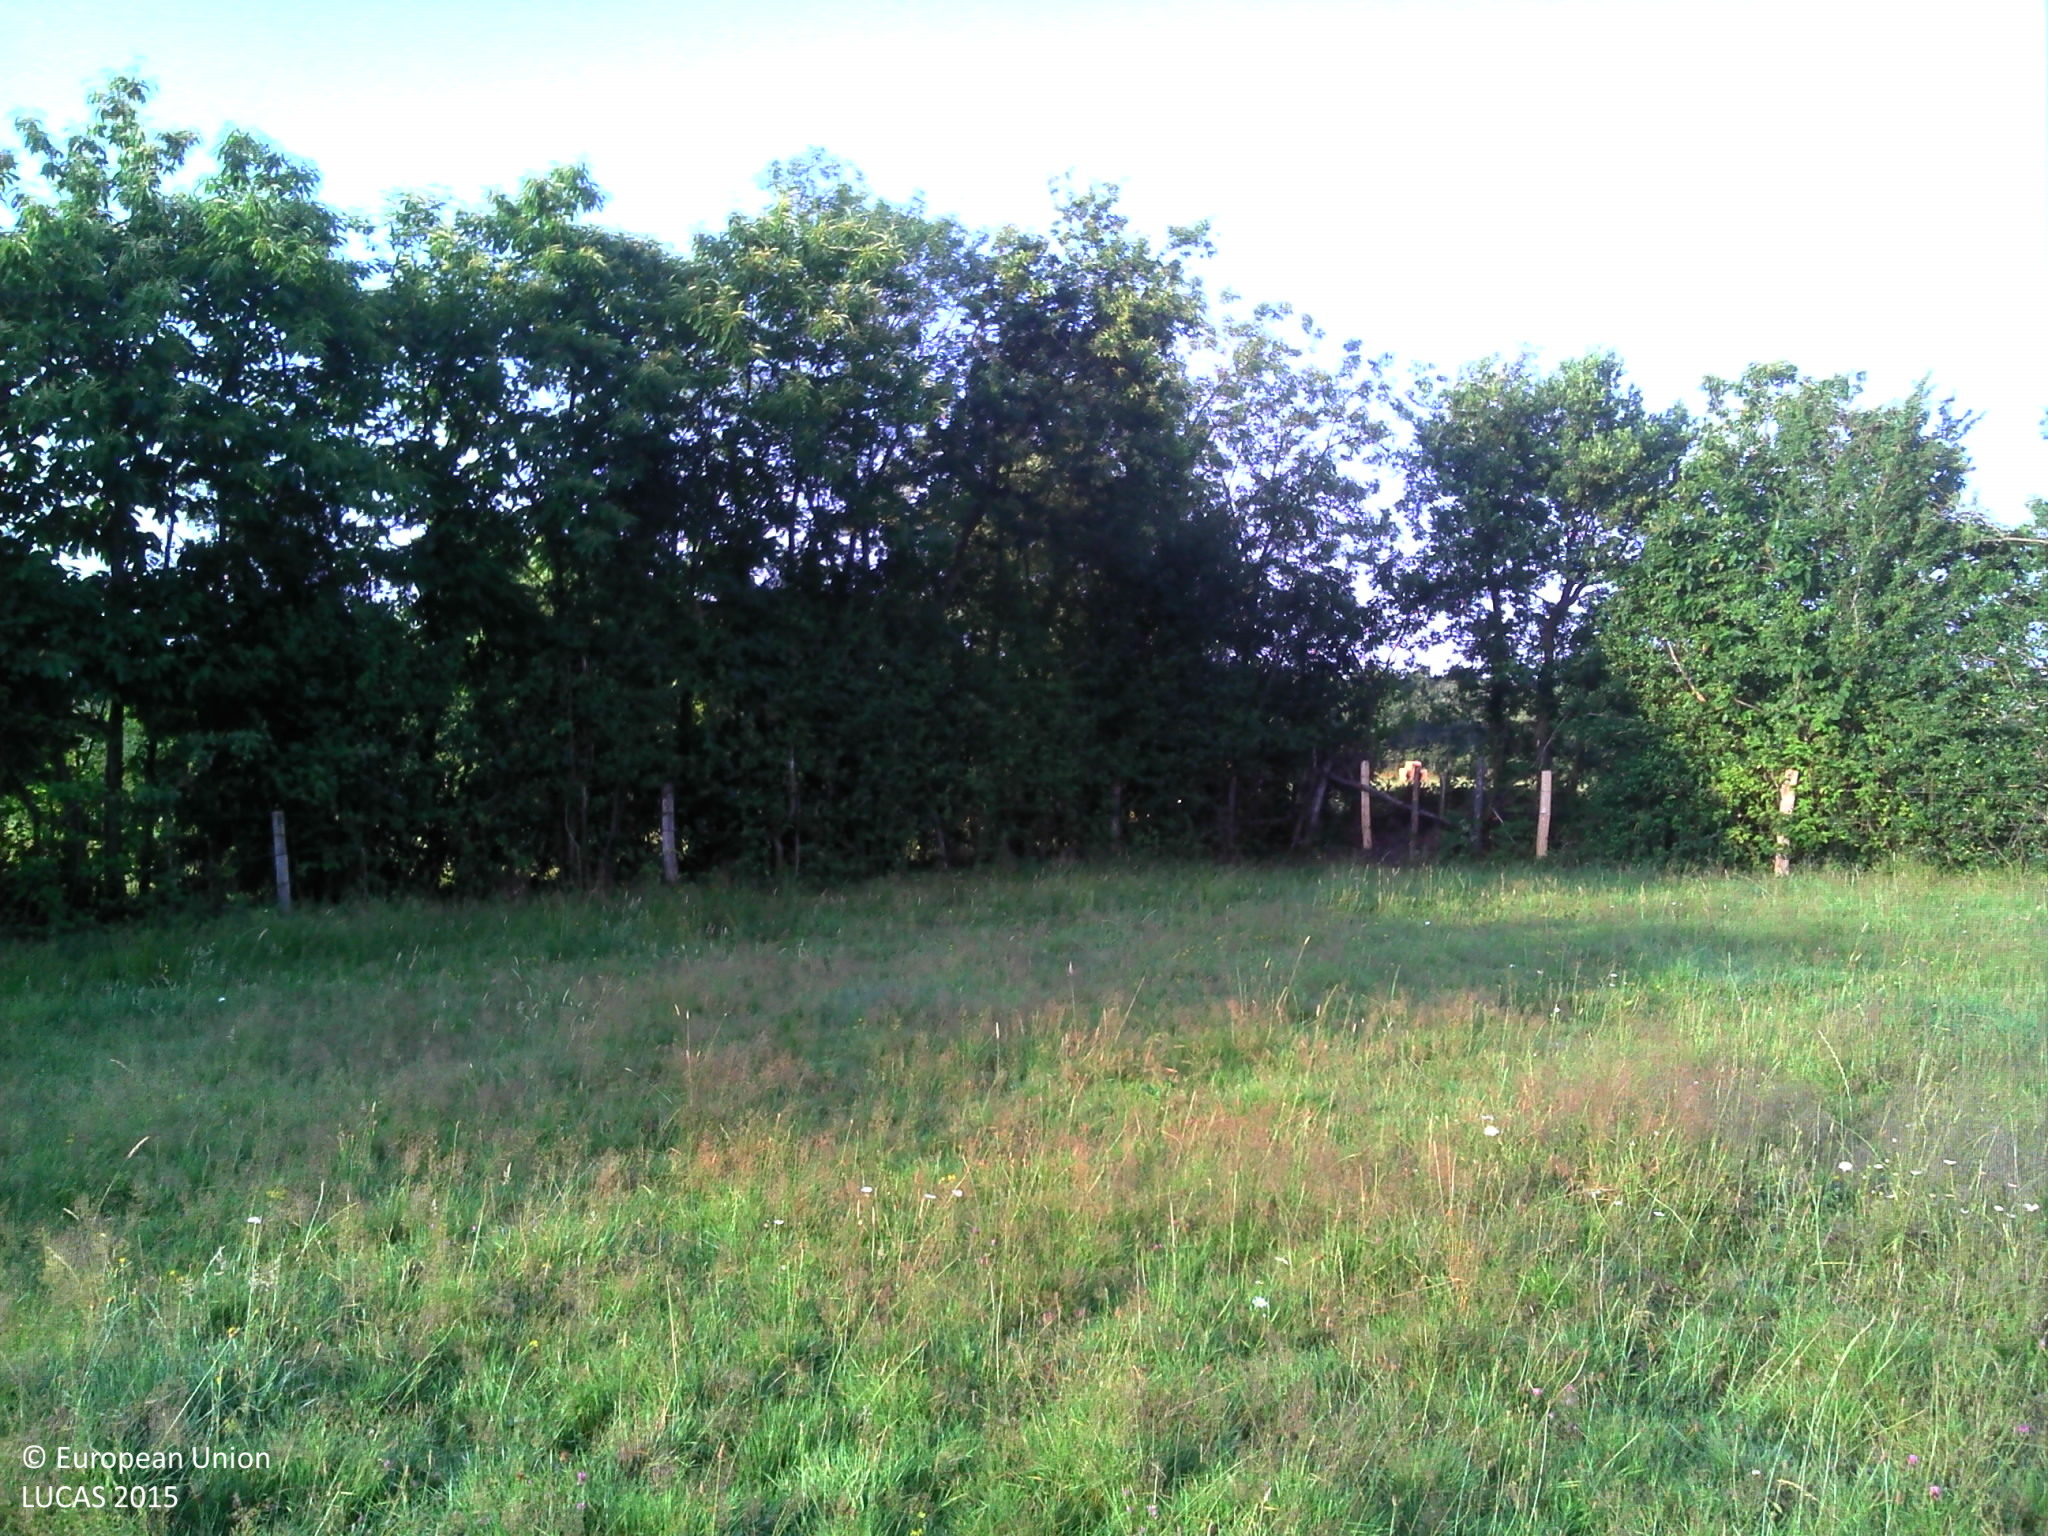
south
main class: Grassland
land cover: Grassland without tree/shrub cover
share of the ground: > 75 %
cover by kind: herbaceous plants 100 %
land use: Agriculture (excluding fallow land and kitchen gardens)
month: July
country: FR
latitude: 47.3167
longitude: -1.7801
